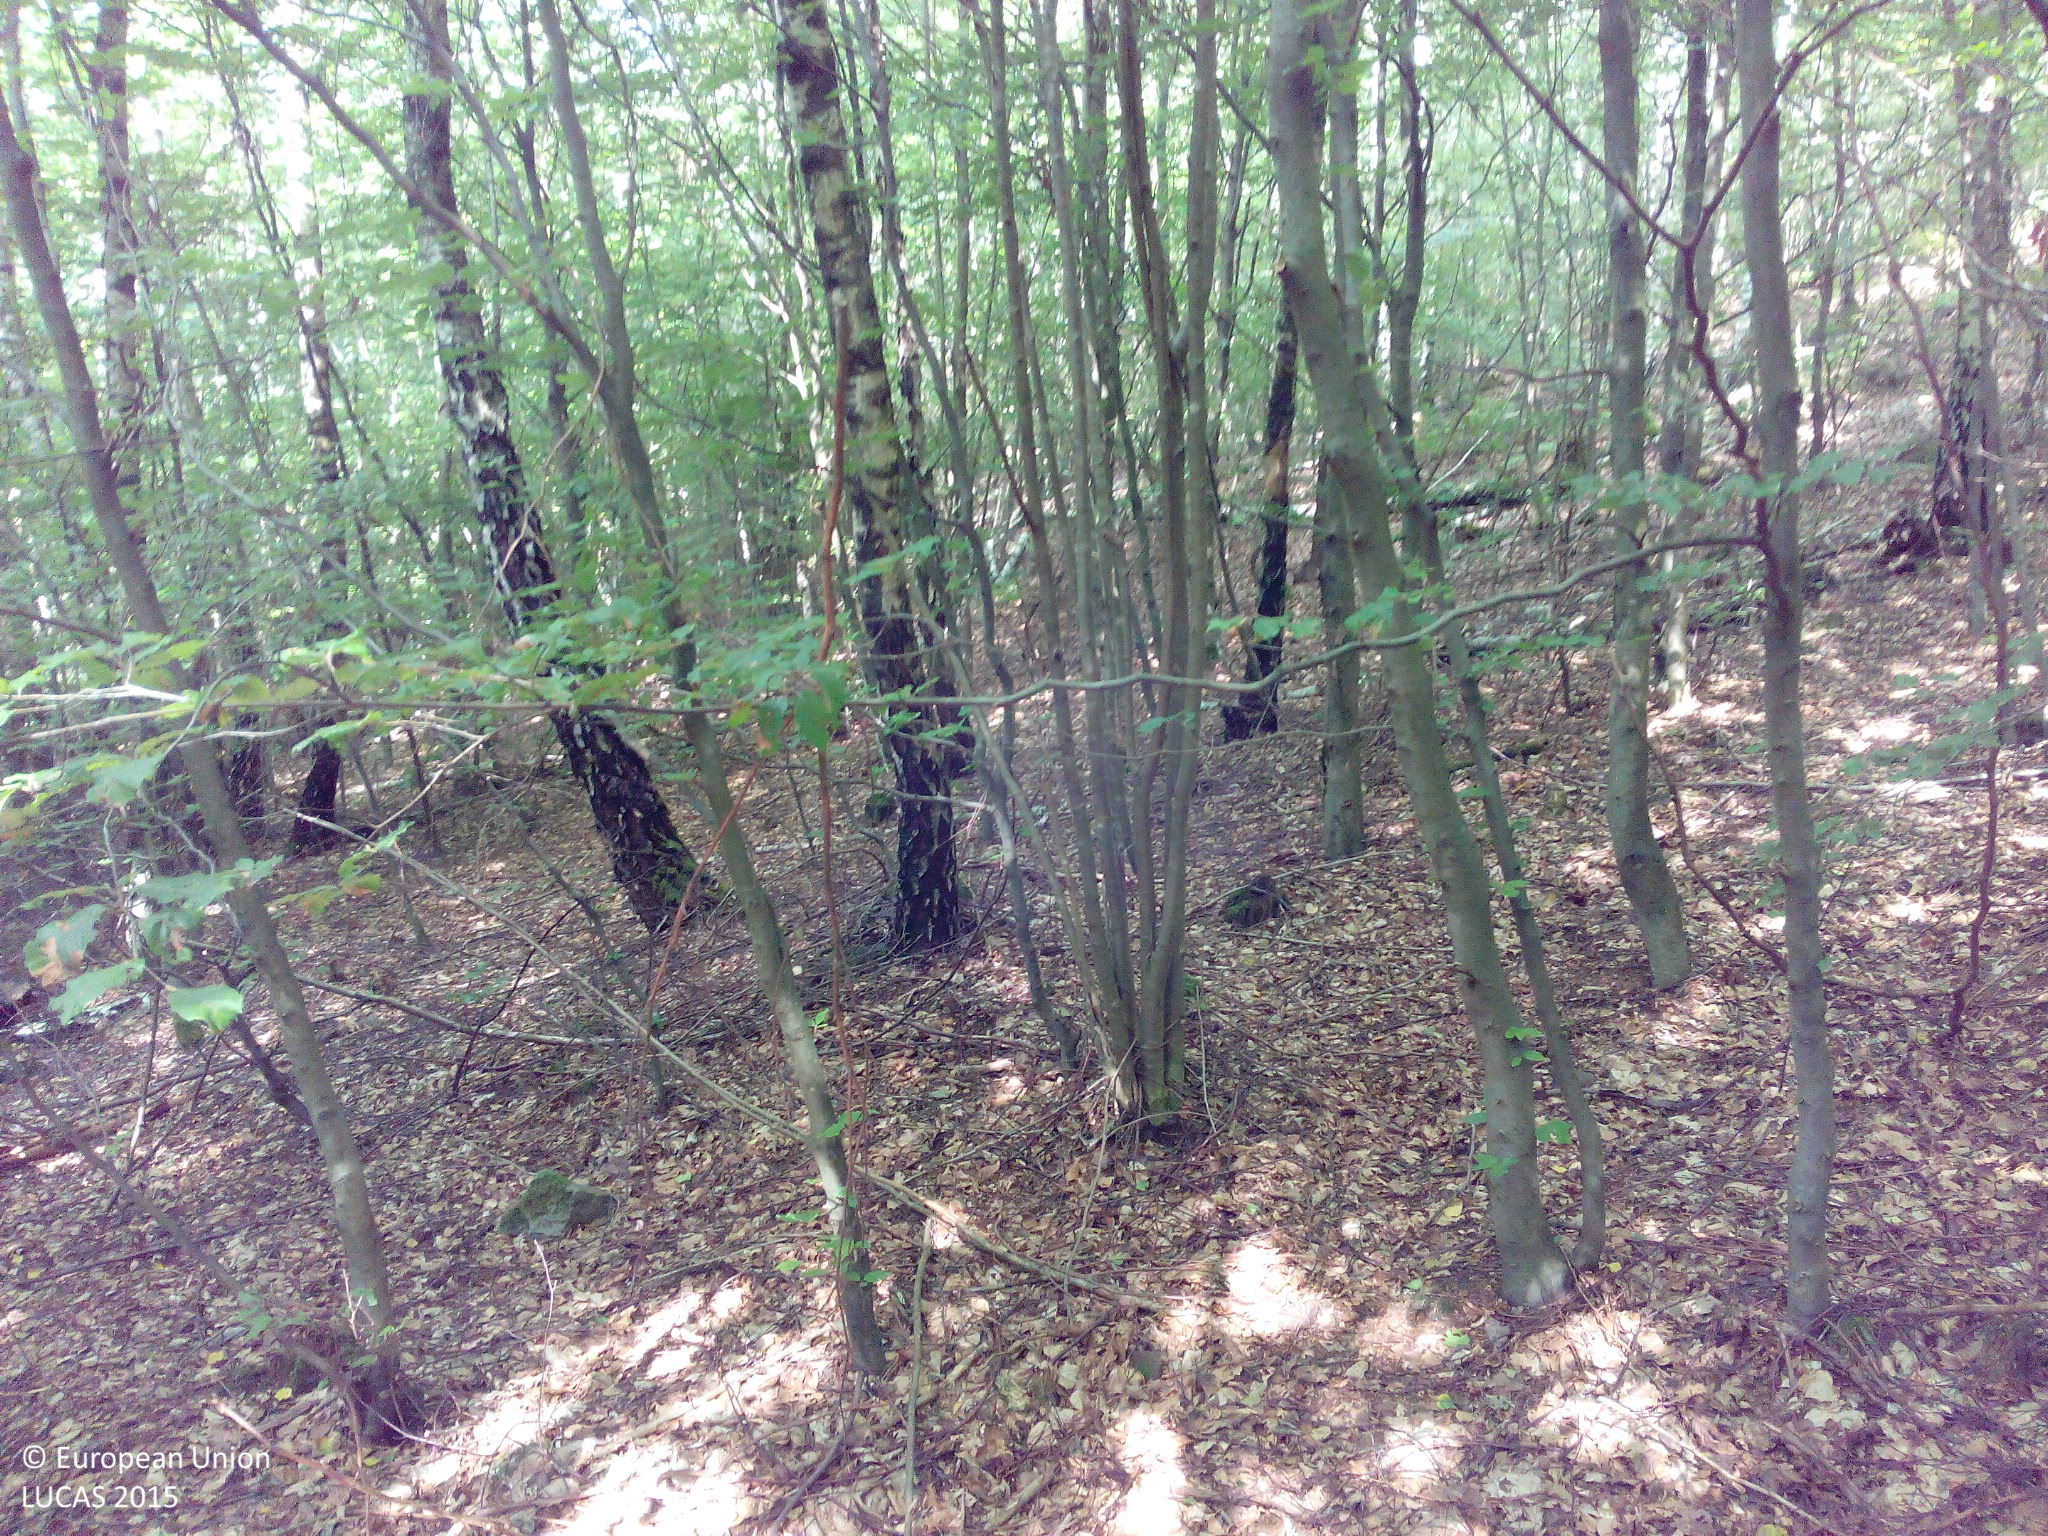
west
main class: Woodland
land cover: Broadleaved woodland
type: beech forest
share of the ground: > 75 %
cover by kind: broadleaved forest trees 100 %
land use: Forestry
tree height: > 5 m
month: July
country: DE
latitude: 50.5798
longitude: 9.9012
